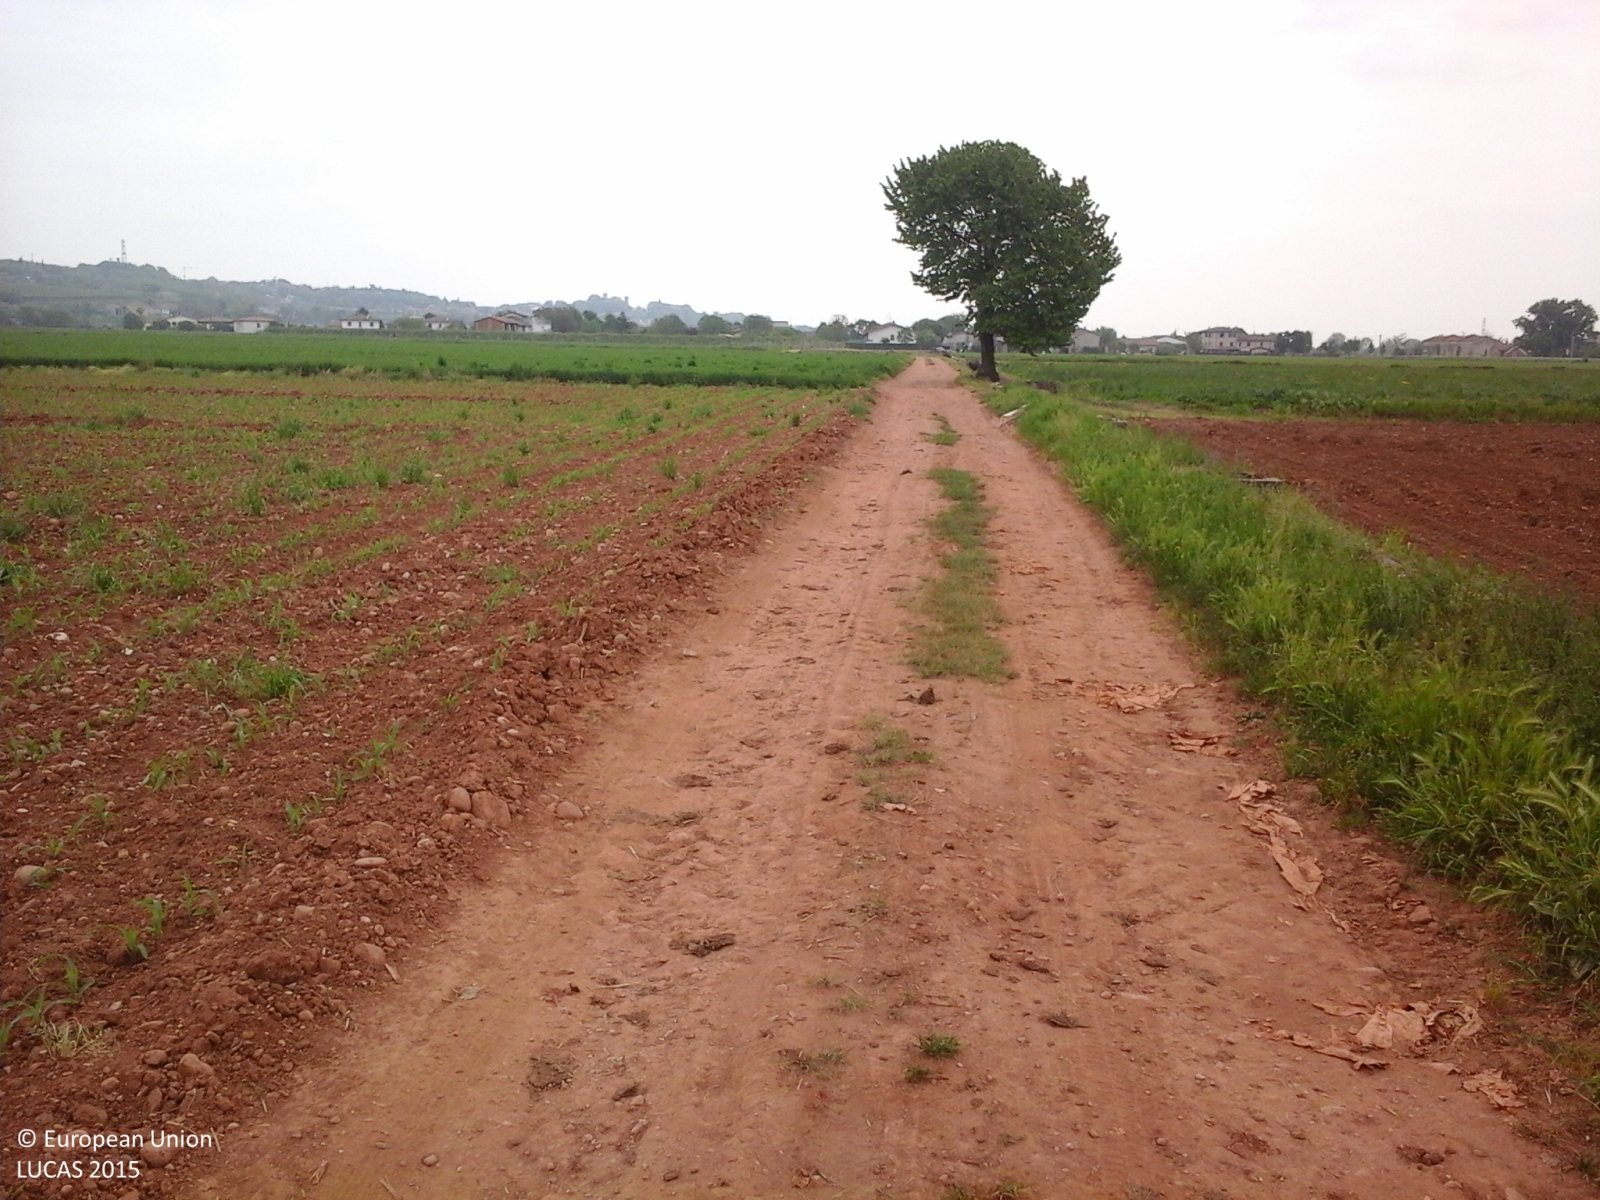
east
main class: Cropland
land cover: Maize
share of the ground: < 10 %
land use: Agriculture (excluding fallow land and kitchen gardens)
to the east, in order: Tracks; Maize; Tracks; Lucerne
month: April
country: IT
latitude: 45.3223
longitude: 10.6240
